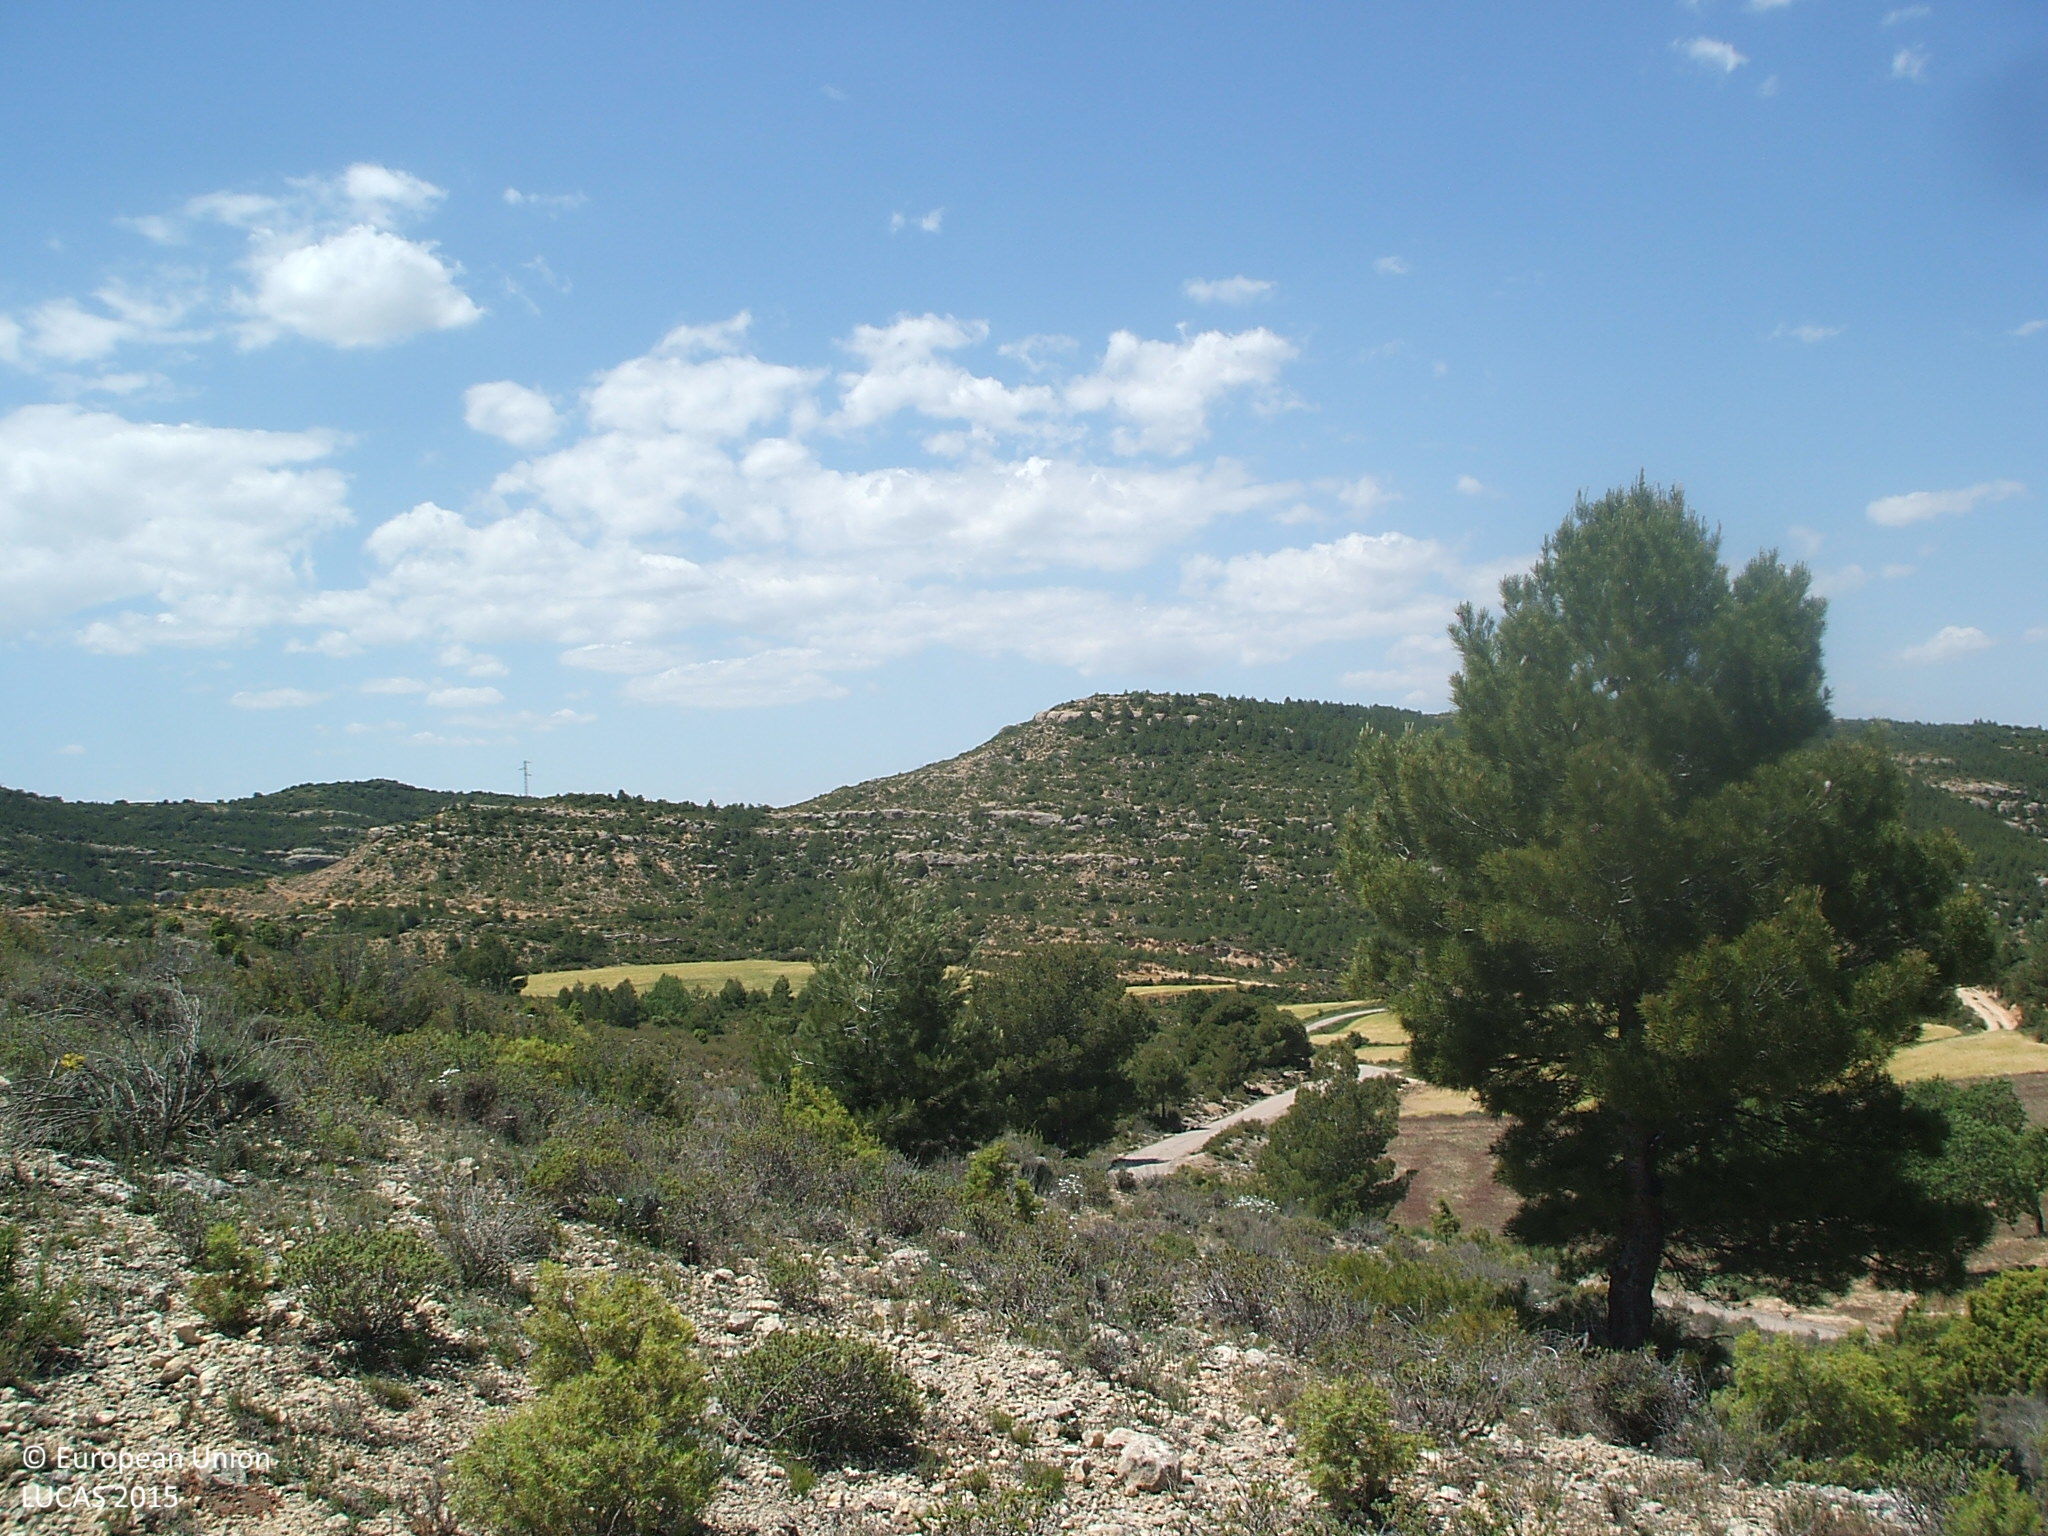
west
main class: Shrubland
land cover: Shrubland with sparse tree cover
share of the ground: 25 - 50 %
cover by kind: consolidated bare surface 55 %, shrubs 20 %, herbaceous plants 20 %, broadleaved forest trees 5 %
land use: Agriculture (excluding fallow land and kitchen gardens)
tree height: > 5 m
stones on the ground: > 50 %
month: May
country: ES
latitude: 40.6928
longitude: -0.2687
